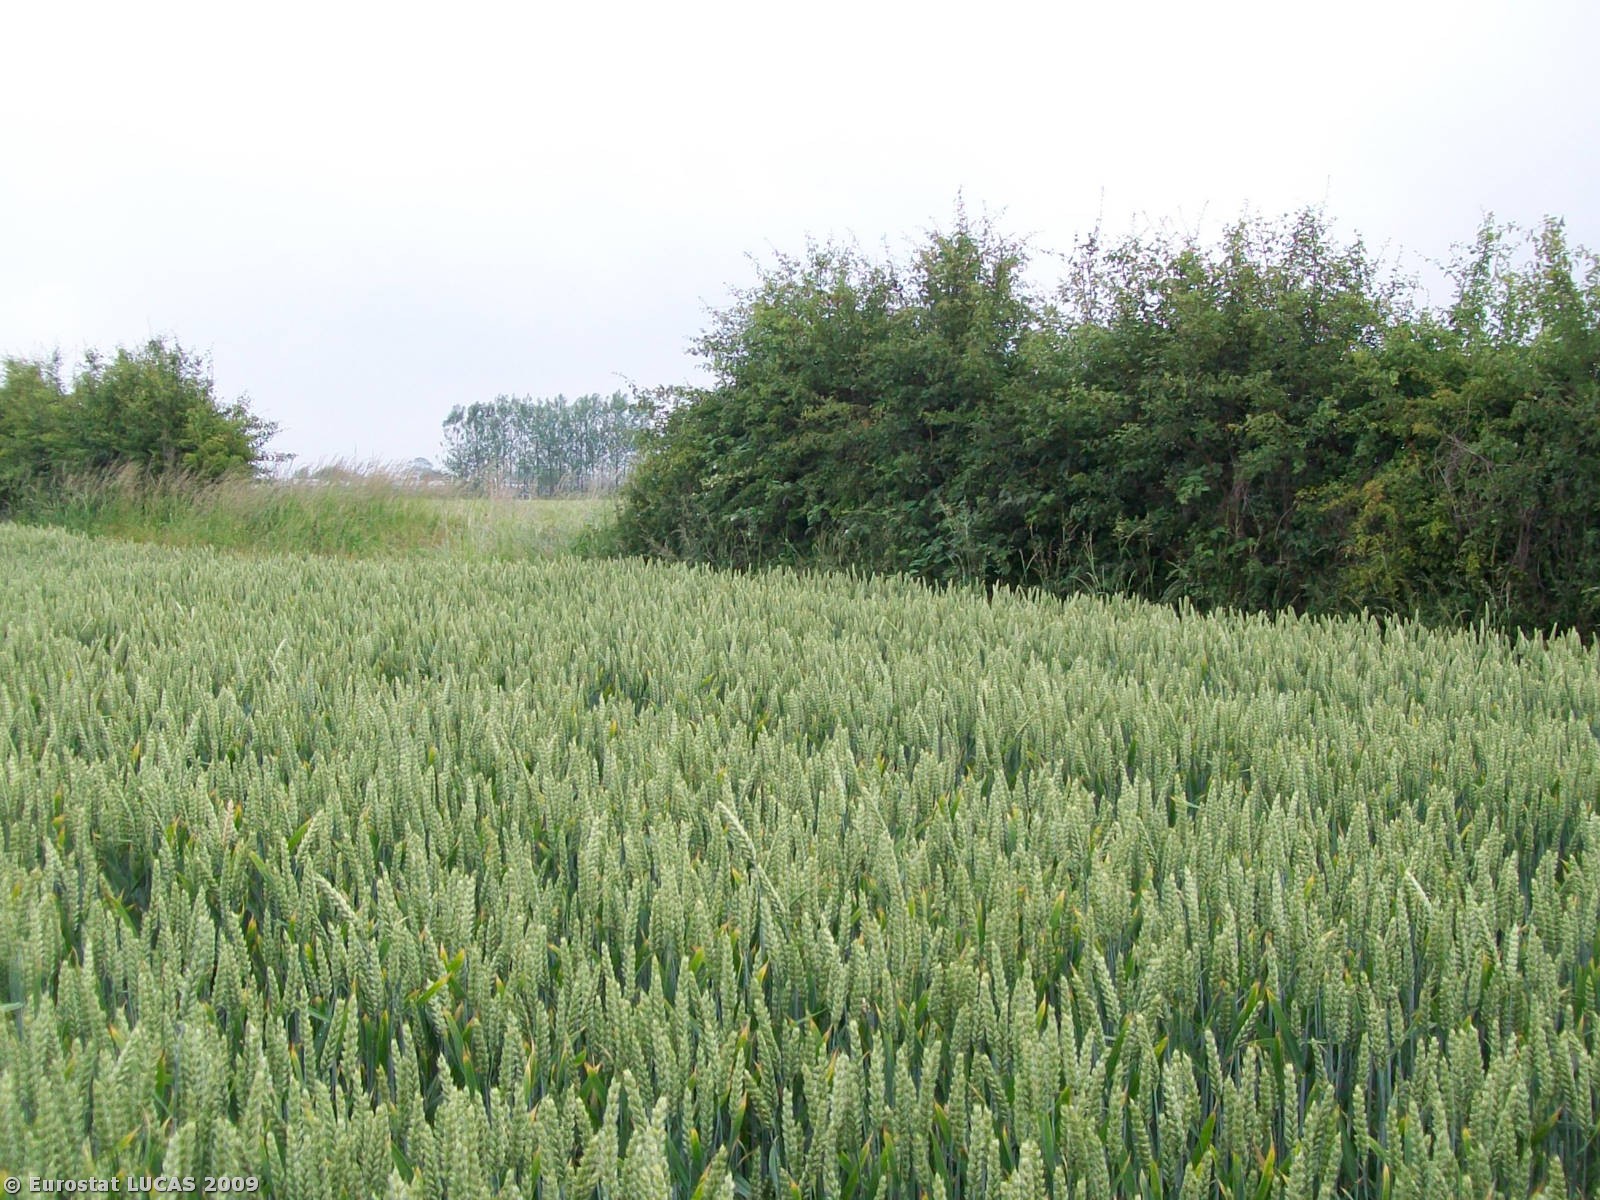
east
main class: Cropland
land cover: Common wheat
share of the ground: < 10 %
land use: Agriculture (excluding fallow land and kitchen gardens)
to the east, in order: Common wheat; Managed hedges; Common wheat; Managed hedges; Paved roads, cycling and walking lanes; Barley
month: June
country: GB
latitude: 54.1995
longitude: -1.4687
